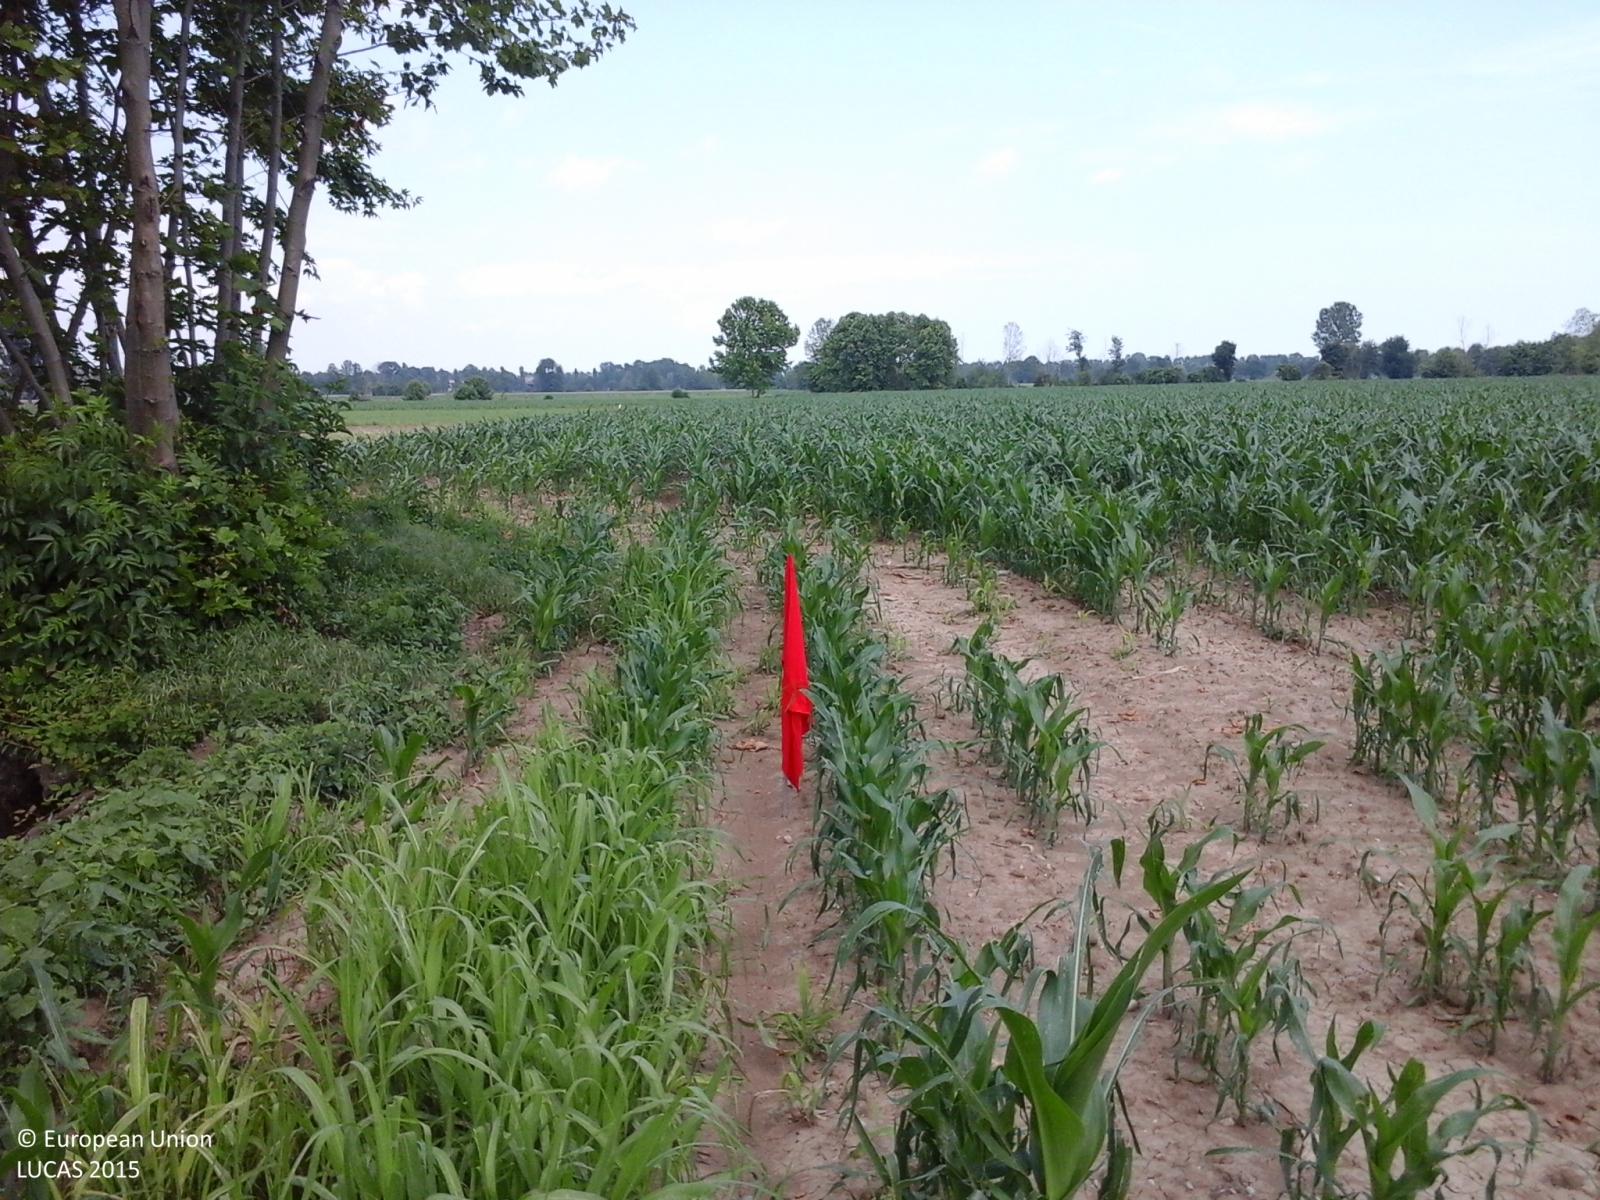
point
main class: Cropland
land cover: Maize
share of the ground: 25 - 50 %
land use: Agriculture (excluding fallow land and kitchen gardens)
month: May
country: IT
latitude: 45.4677
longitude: 9.6297
